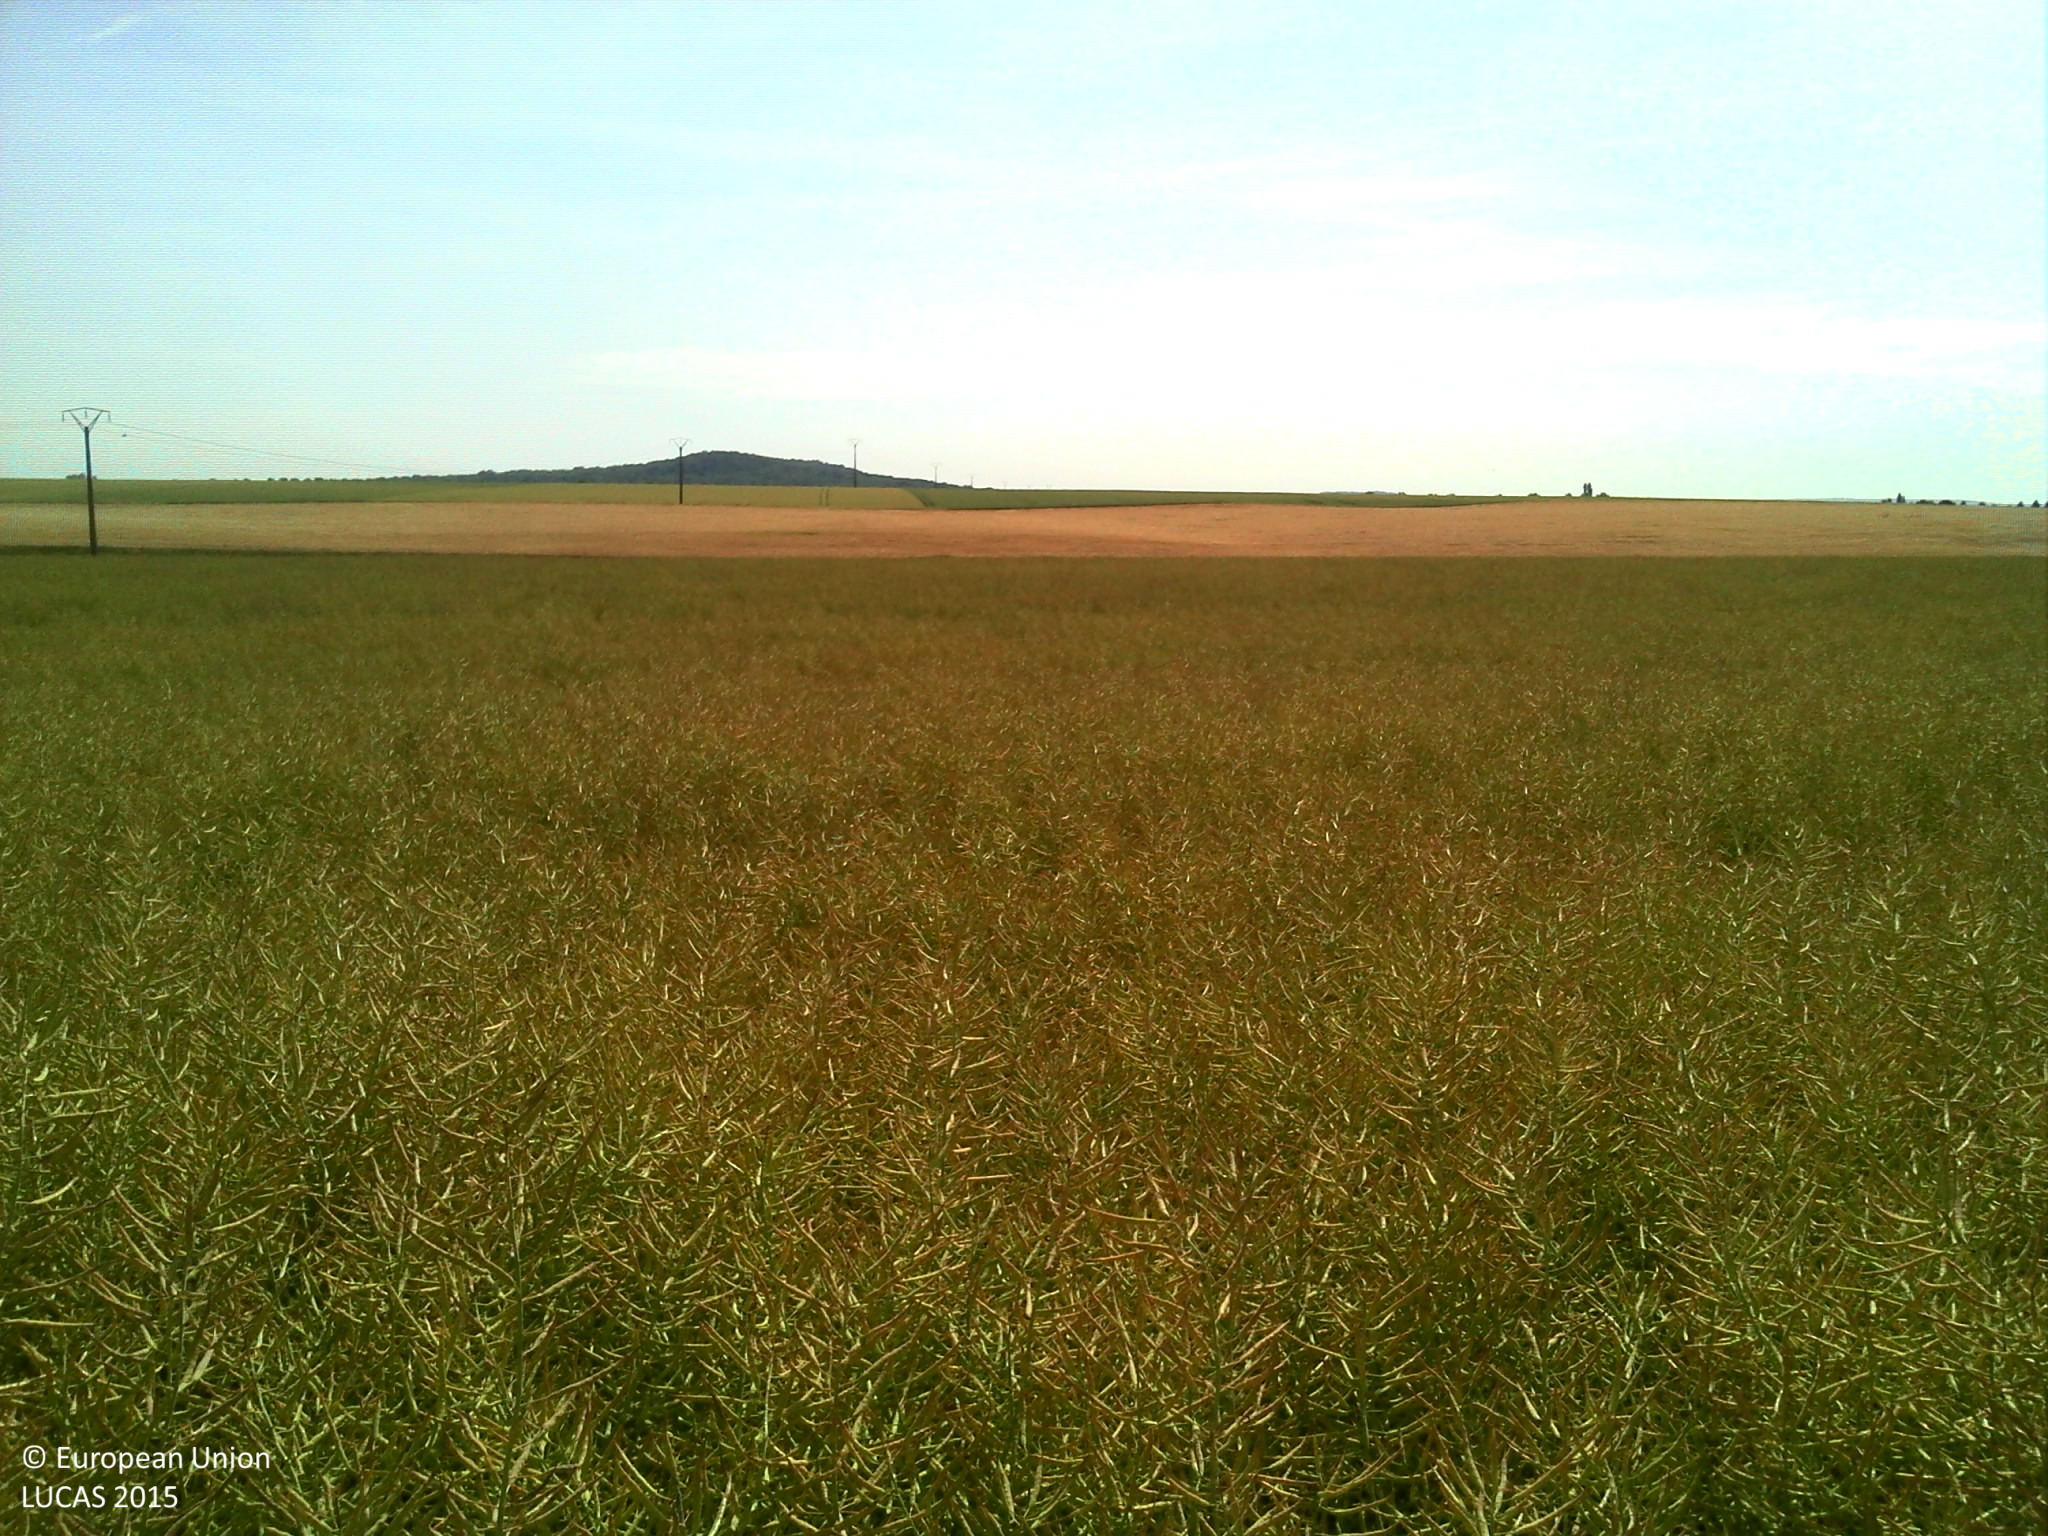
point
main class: Cropland
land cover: Rape and turnip rape
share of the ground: > 75 %
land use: Agriculture (excluding fallow land and kitchen gardens)
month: June
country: FR
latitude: 49.3653
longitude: 2.5941
